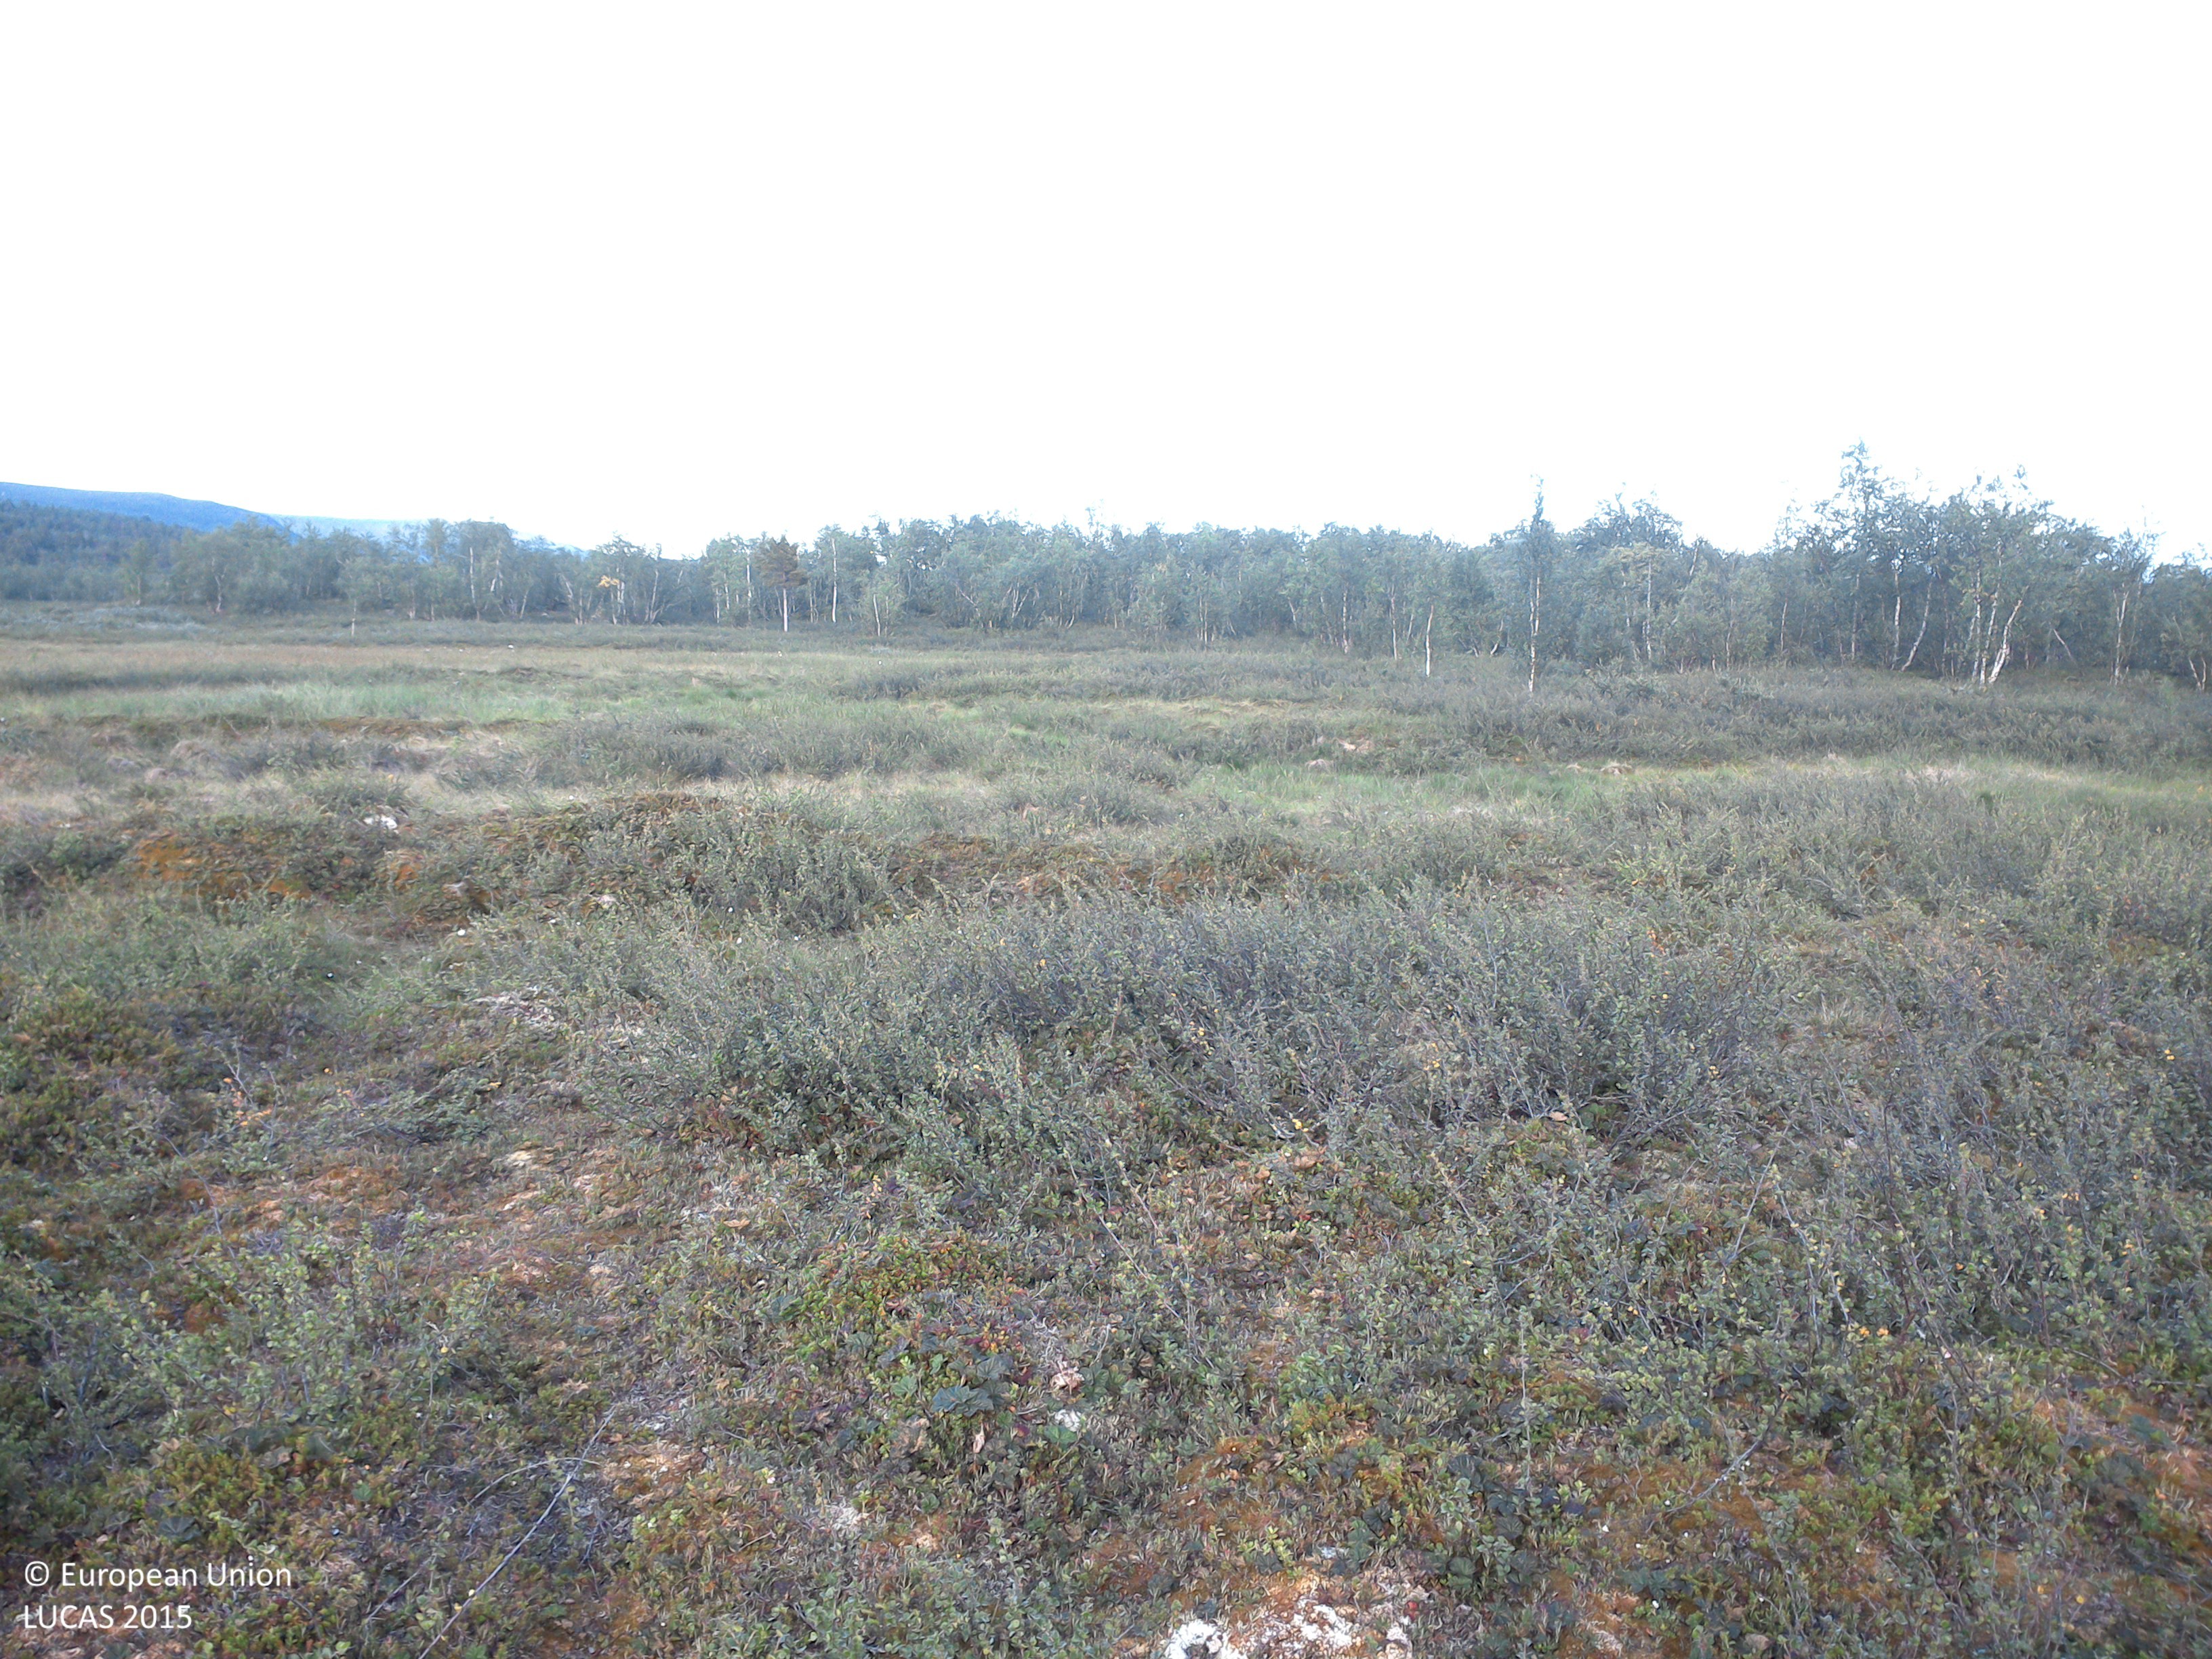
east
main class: Shrubland
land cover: Shrubland without tree cover
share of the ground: 25 - 50 %
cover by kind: shrubs 45 %, lichens and mosses 40 %, herbaceous plants 15 %
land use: Semi-natural and natural areas not in use
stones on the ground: < 10 %
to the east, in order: Shrubland without tree cover; Peatbogs; Shrubland without tree cover; Broadleaved woodland; Shrubland without tree cover; Broadleaved woodland
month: August
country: SE
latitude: 67.8648
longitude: 19.2837
